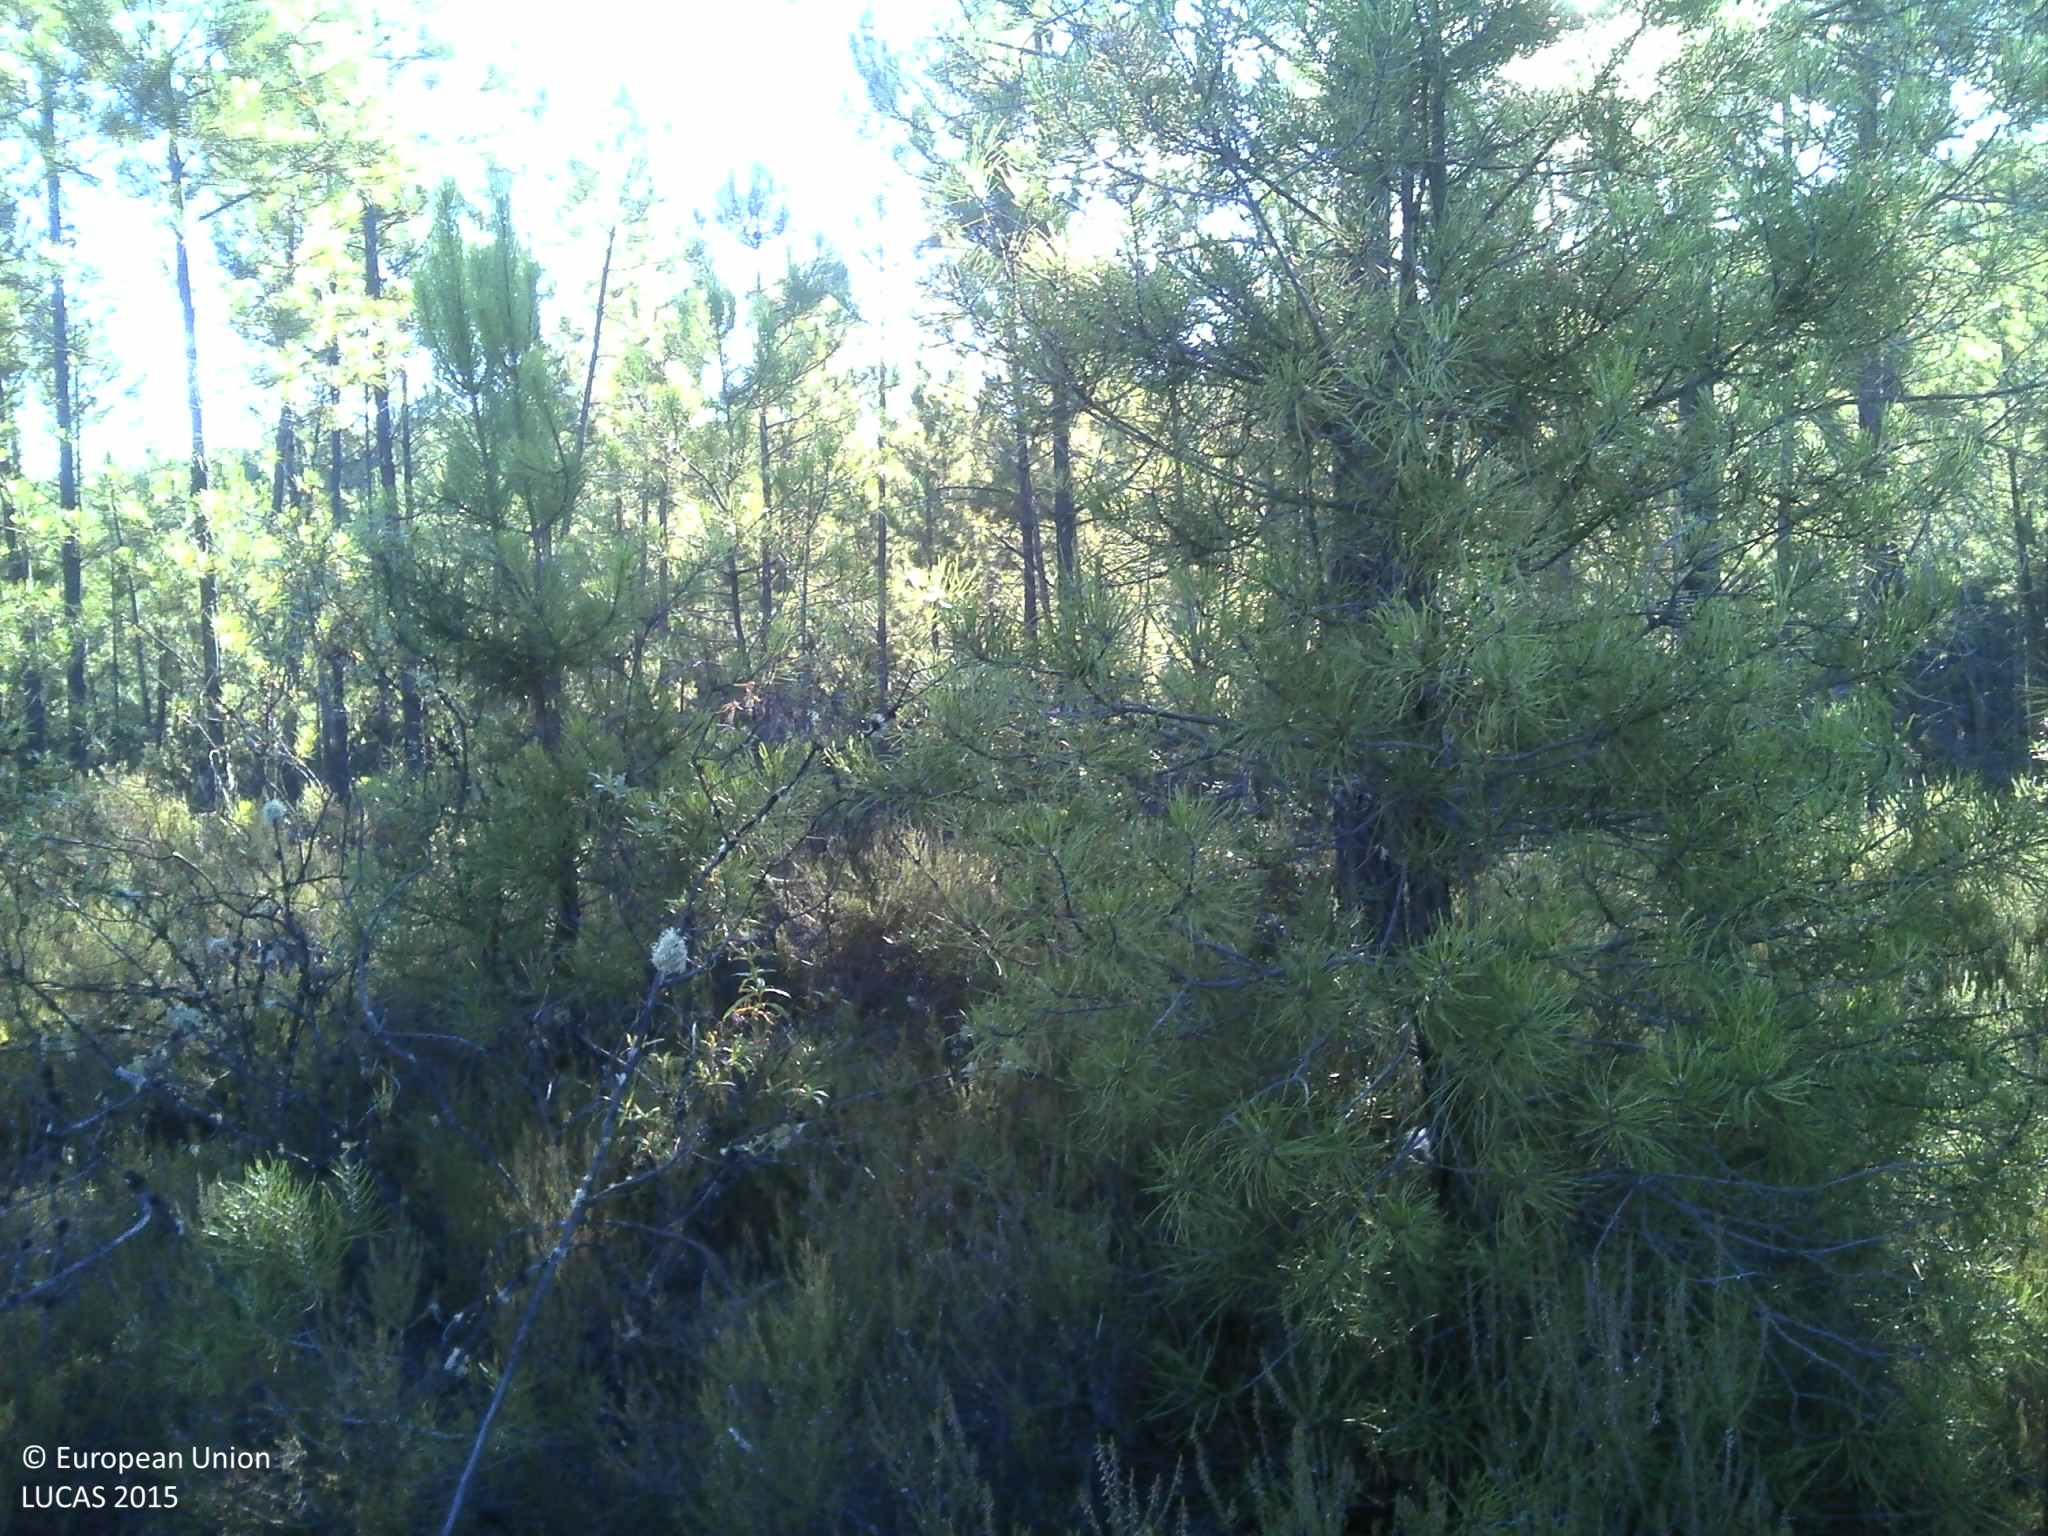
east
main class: Woodland
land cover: Pine dominated coniferous woodland
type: coniferous forest of the mediterranean region
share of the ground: 50 - 75 %
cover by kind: coniferous forest trees 70 %, shrubs 20 %, unconsolidated bare surface 5 %
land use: Forestry
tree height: > 5 m
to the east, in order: Pine dominated coniferous woodland; Tracks; Pine dominated coniferous woodland; Tracks
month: July
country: PT
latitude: 39.9890
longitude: -7.6135
